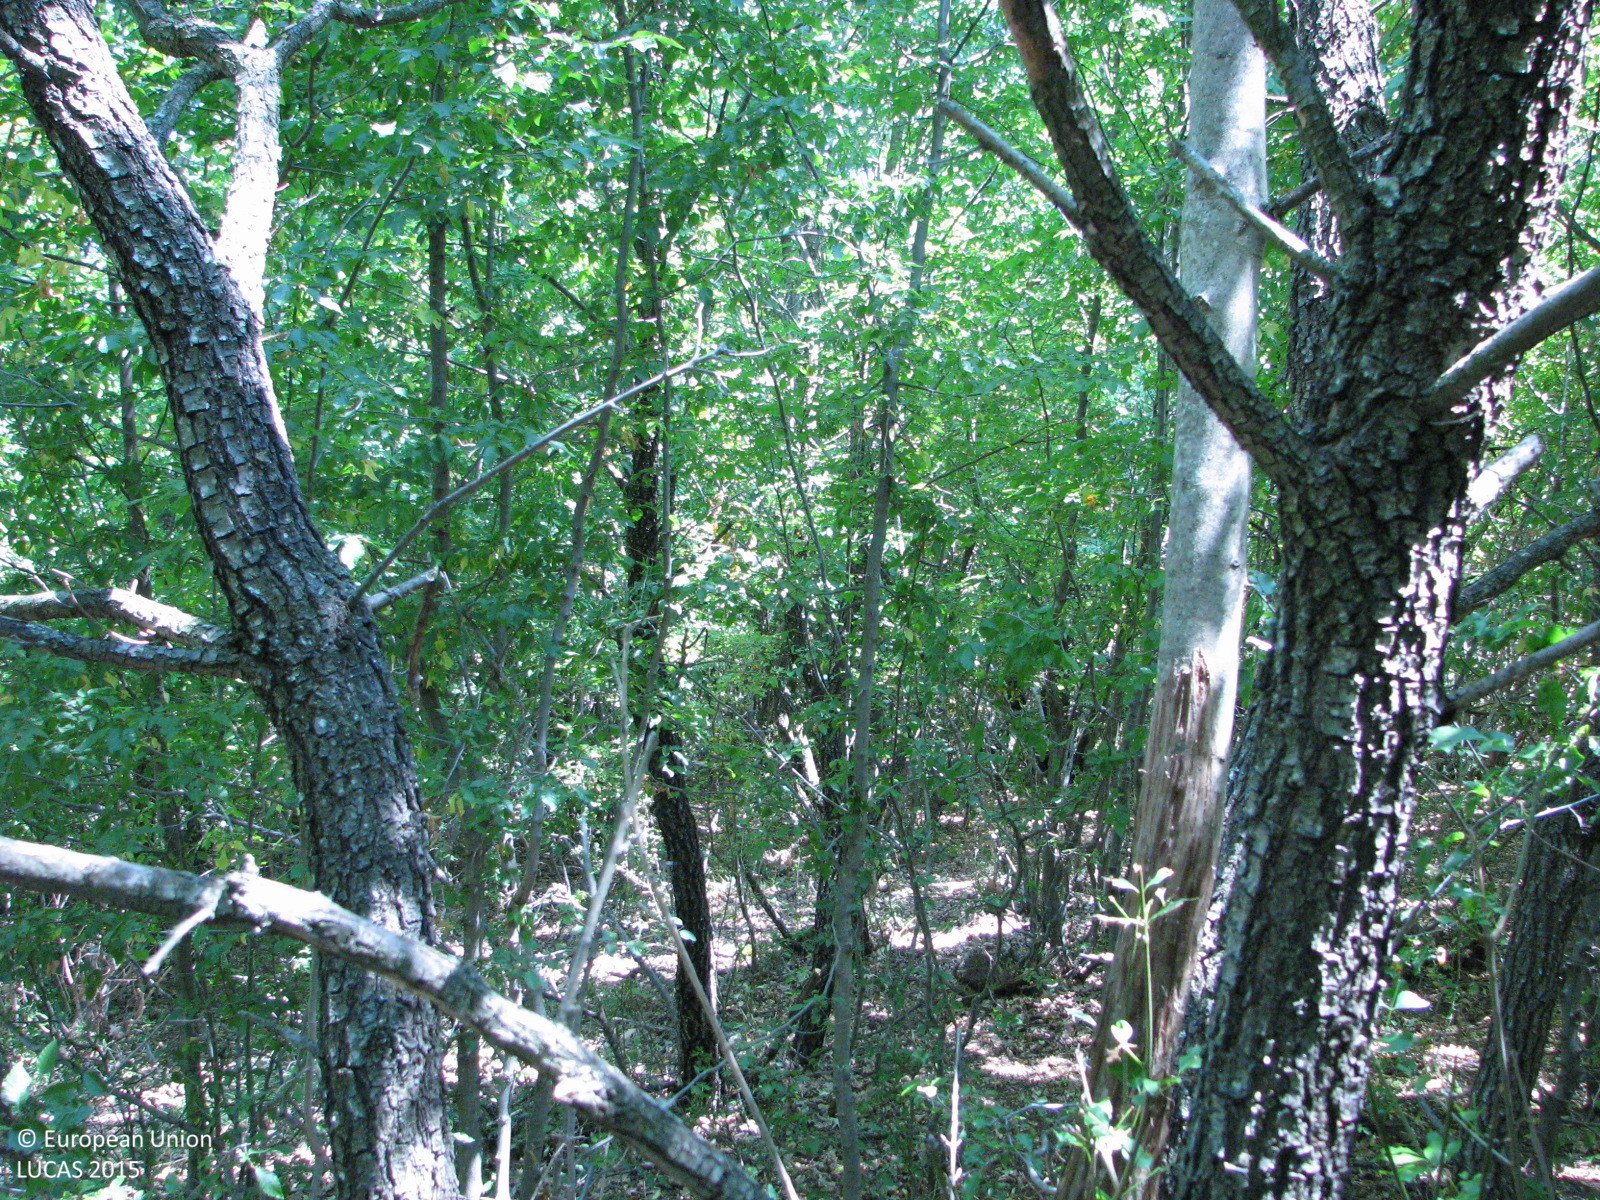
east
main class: Woodland
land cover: Broadleaved woodland
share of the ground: 50 - 75 %
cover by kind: broadleaved forest trees 50 %, herbaceous plants 40 %, shrubs 10 %
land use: Forestry
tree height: < 5 m
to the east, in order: Broadleaved woodland; Shrubland with sparse tree cover; Rocks and stones
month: July
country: BG
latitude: 42.6466
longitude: 26.0746
